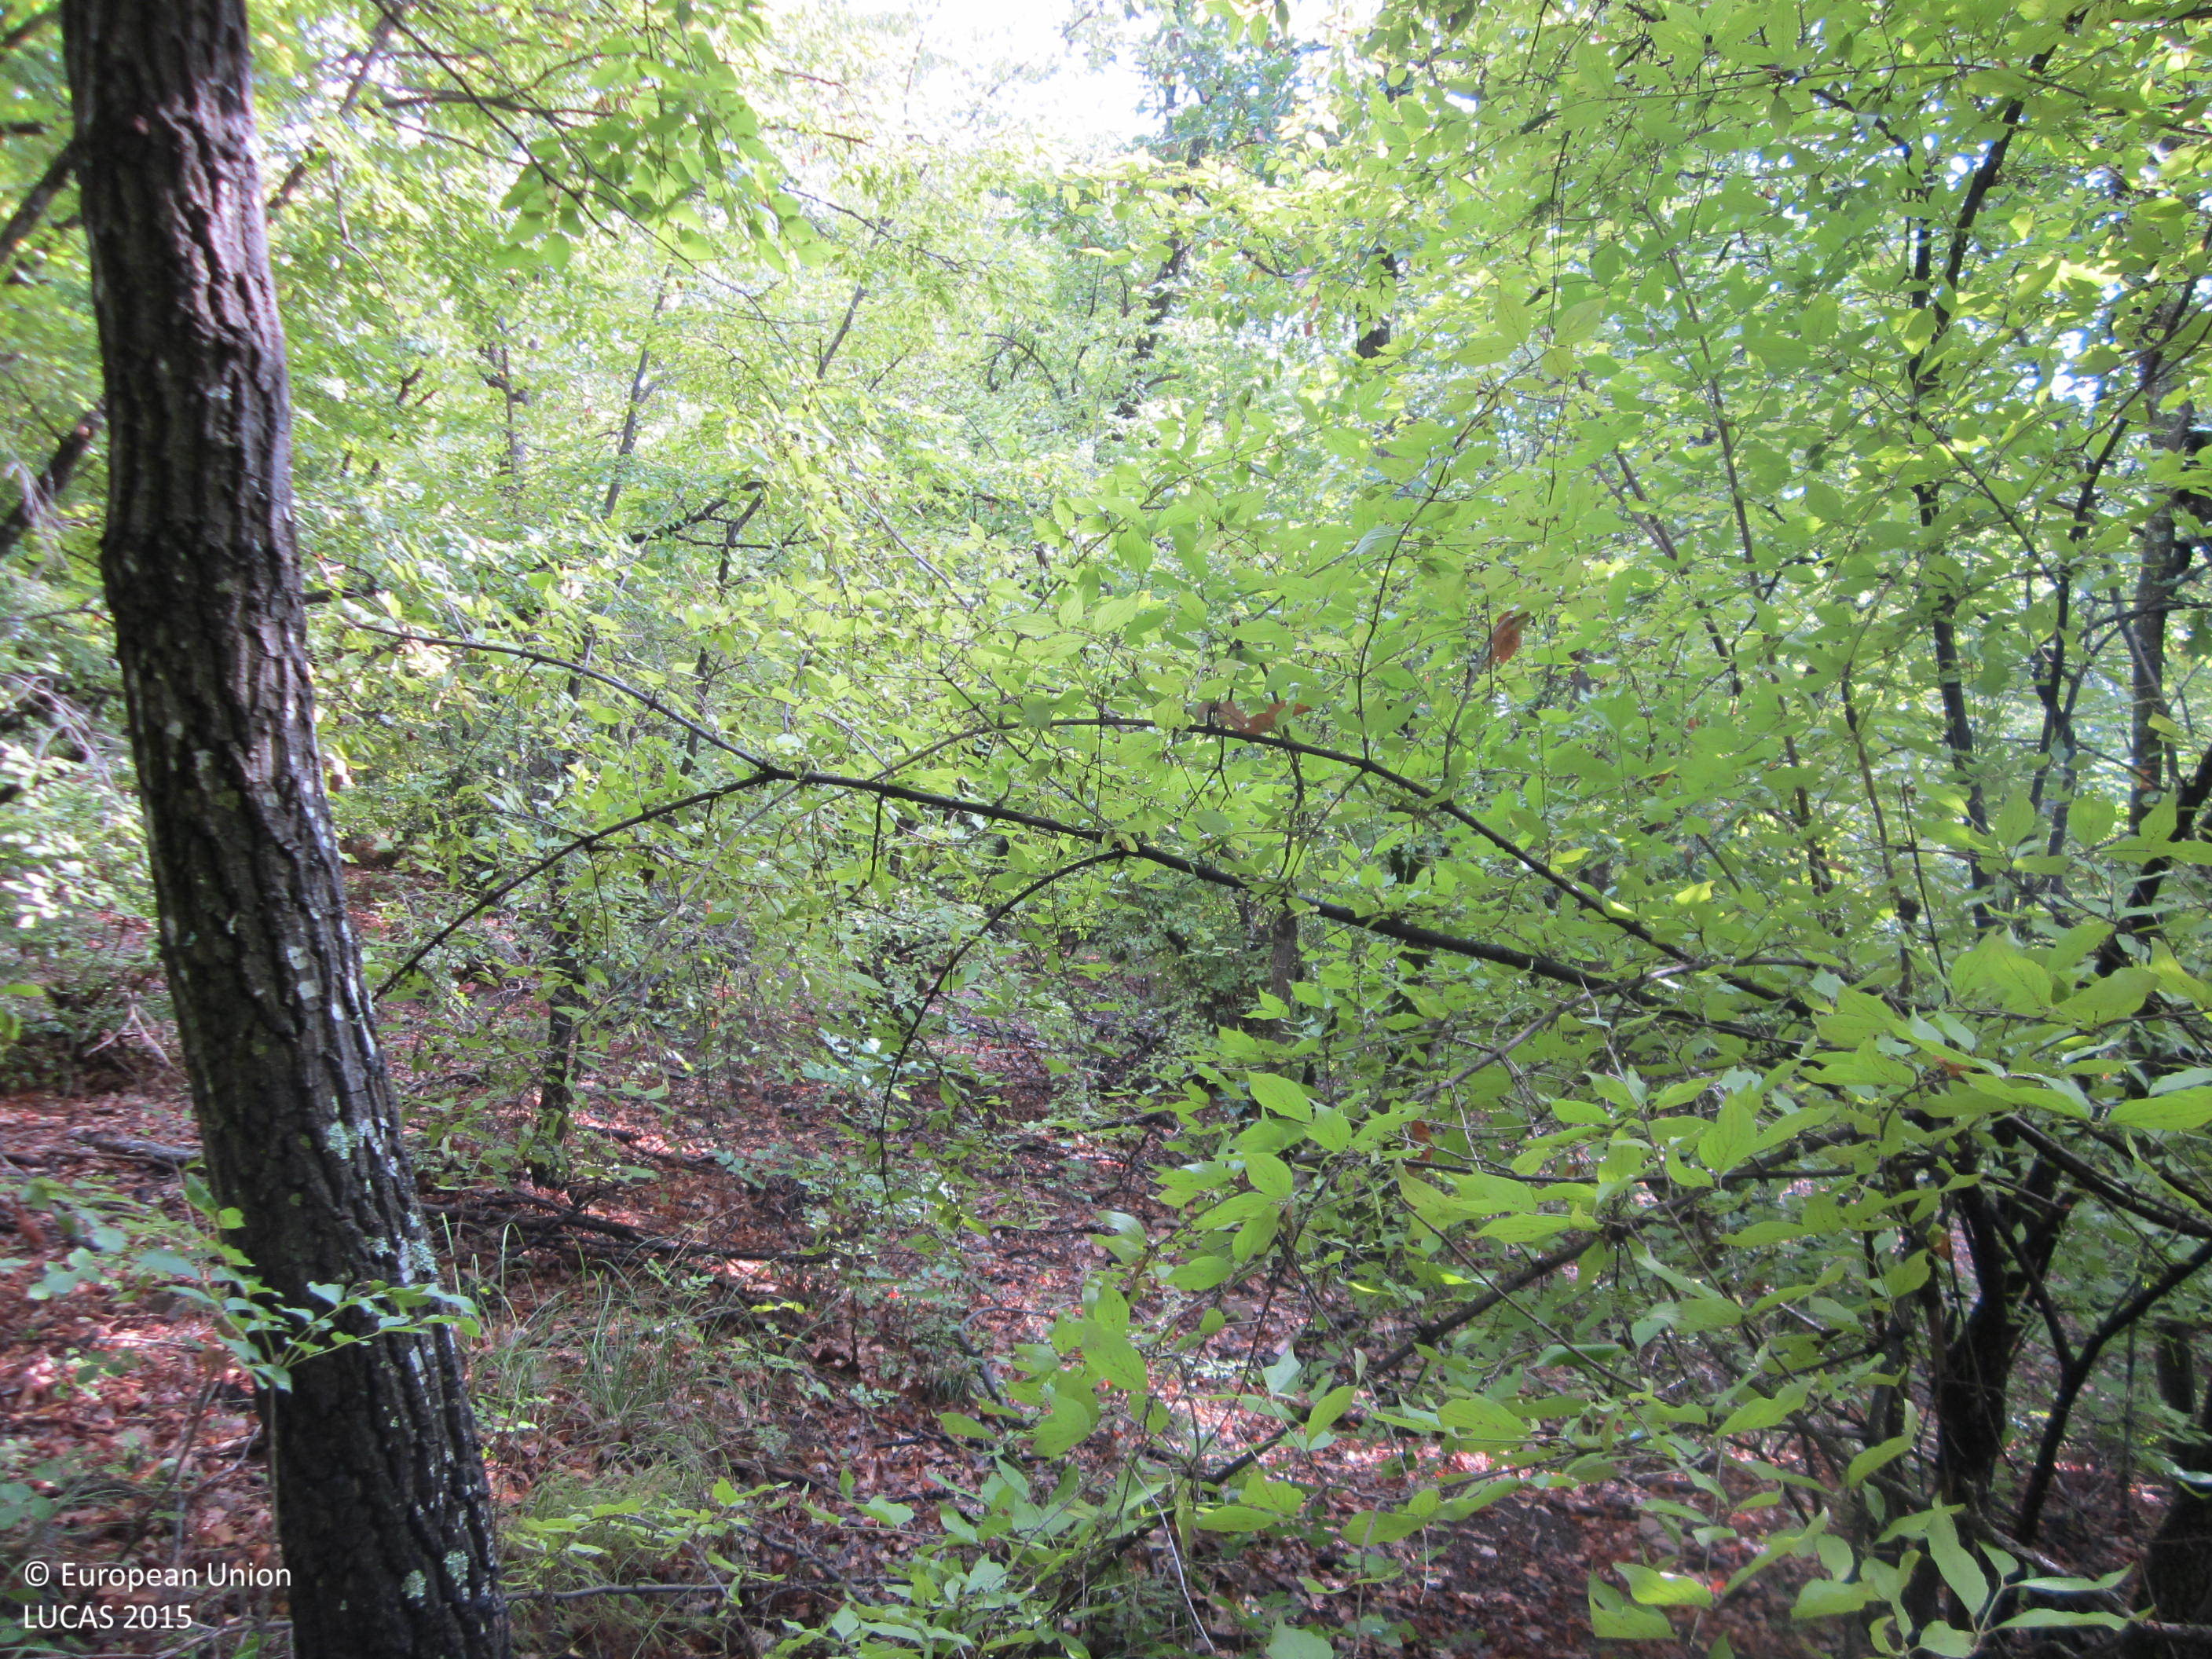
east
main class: Woodland
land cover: Broadleaved woodland
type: acidophilous oak and oak-birch forest
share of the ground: 50 - 75 %
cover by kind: broadleaved forest trees 70 %, unconsolidated bare surface 15 %, herbaceous plants 10 %, shrubs 5 %
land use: Forestry
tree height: > 5 m
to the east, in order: Broadleaved woodland; Tracks; Broadleaved woodland
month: October
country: BG
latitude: 42.7636
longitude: 26.7077
